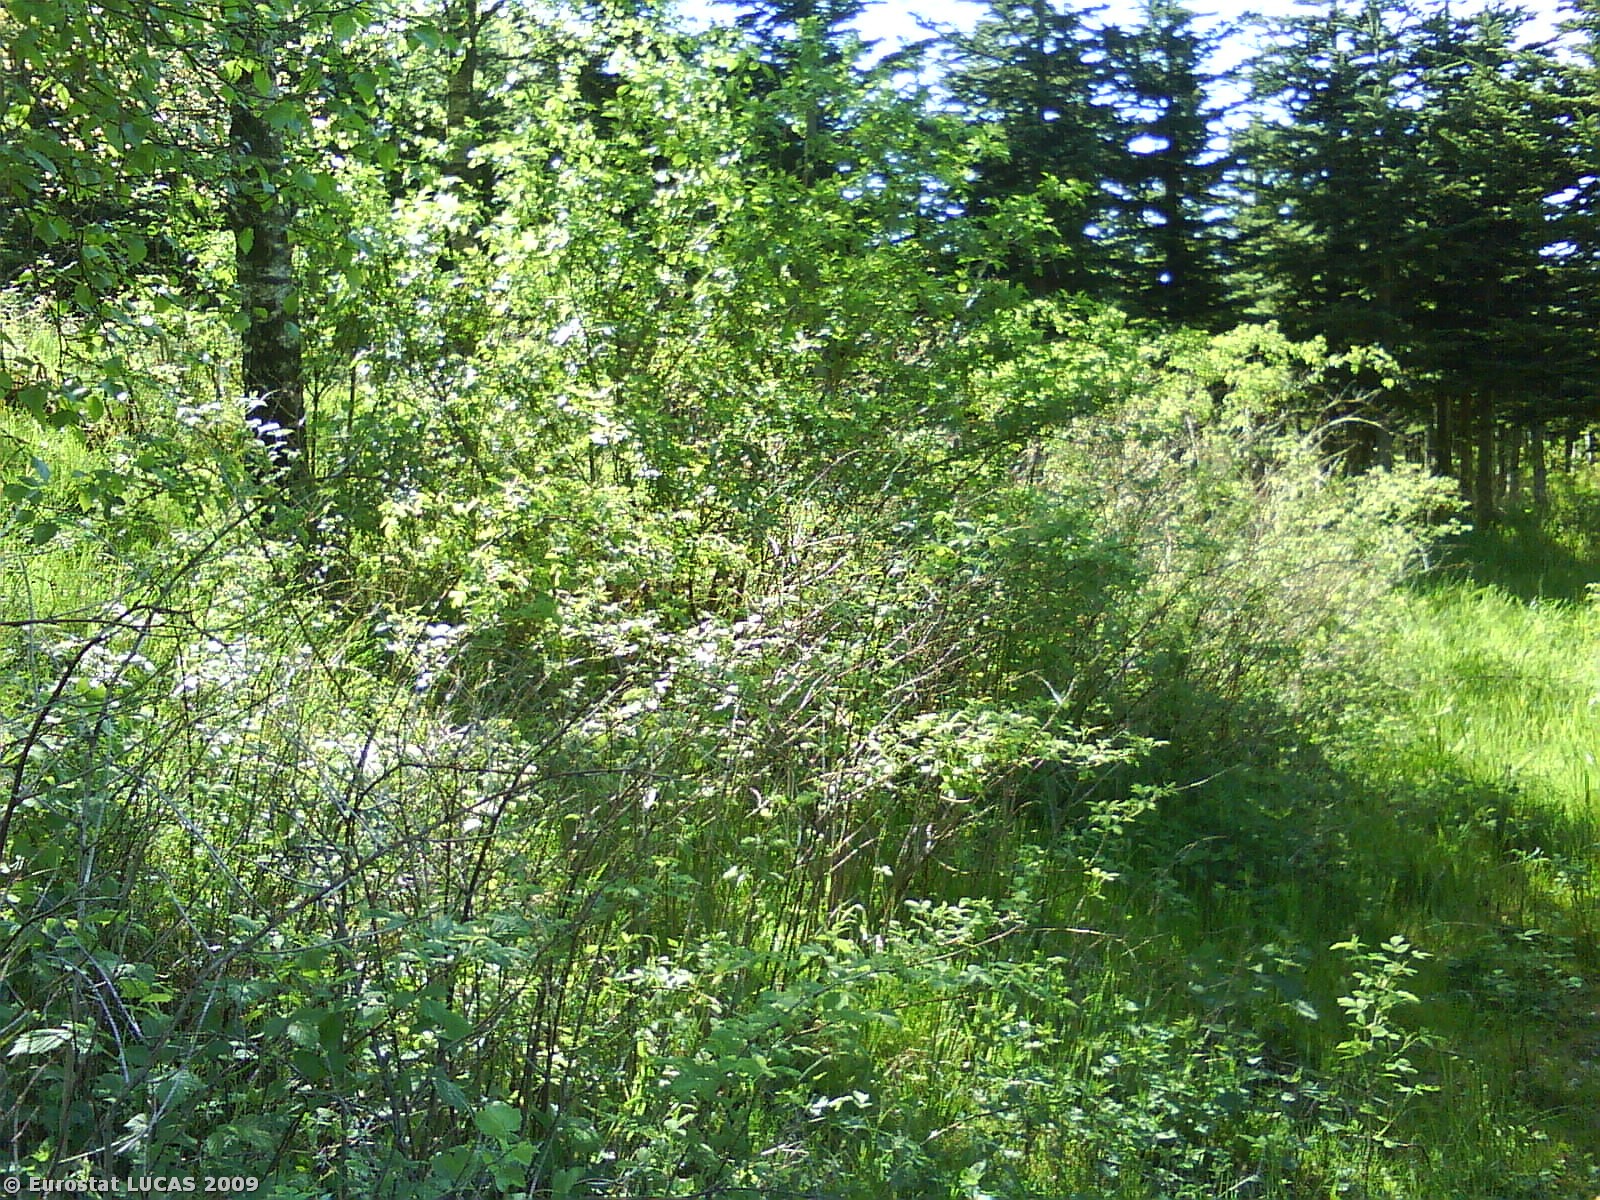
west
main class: Woodland
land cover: Broadleaved woodland
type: plantations and self-sown exotic forest
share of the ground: 25 - 50 %
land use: Forestry
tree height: > 5 m
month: May
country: DK
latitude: 56.4549
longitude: 10.7941
